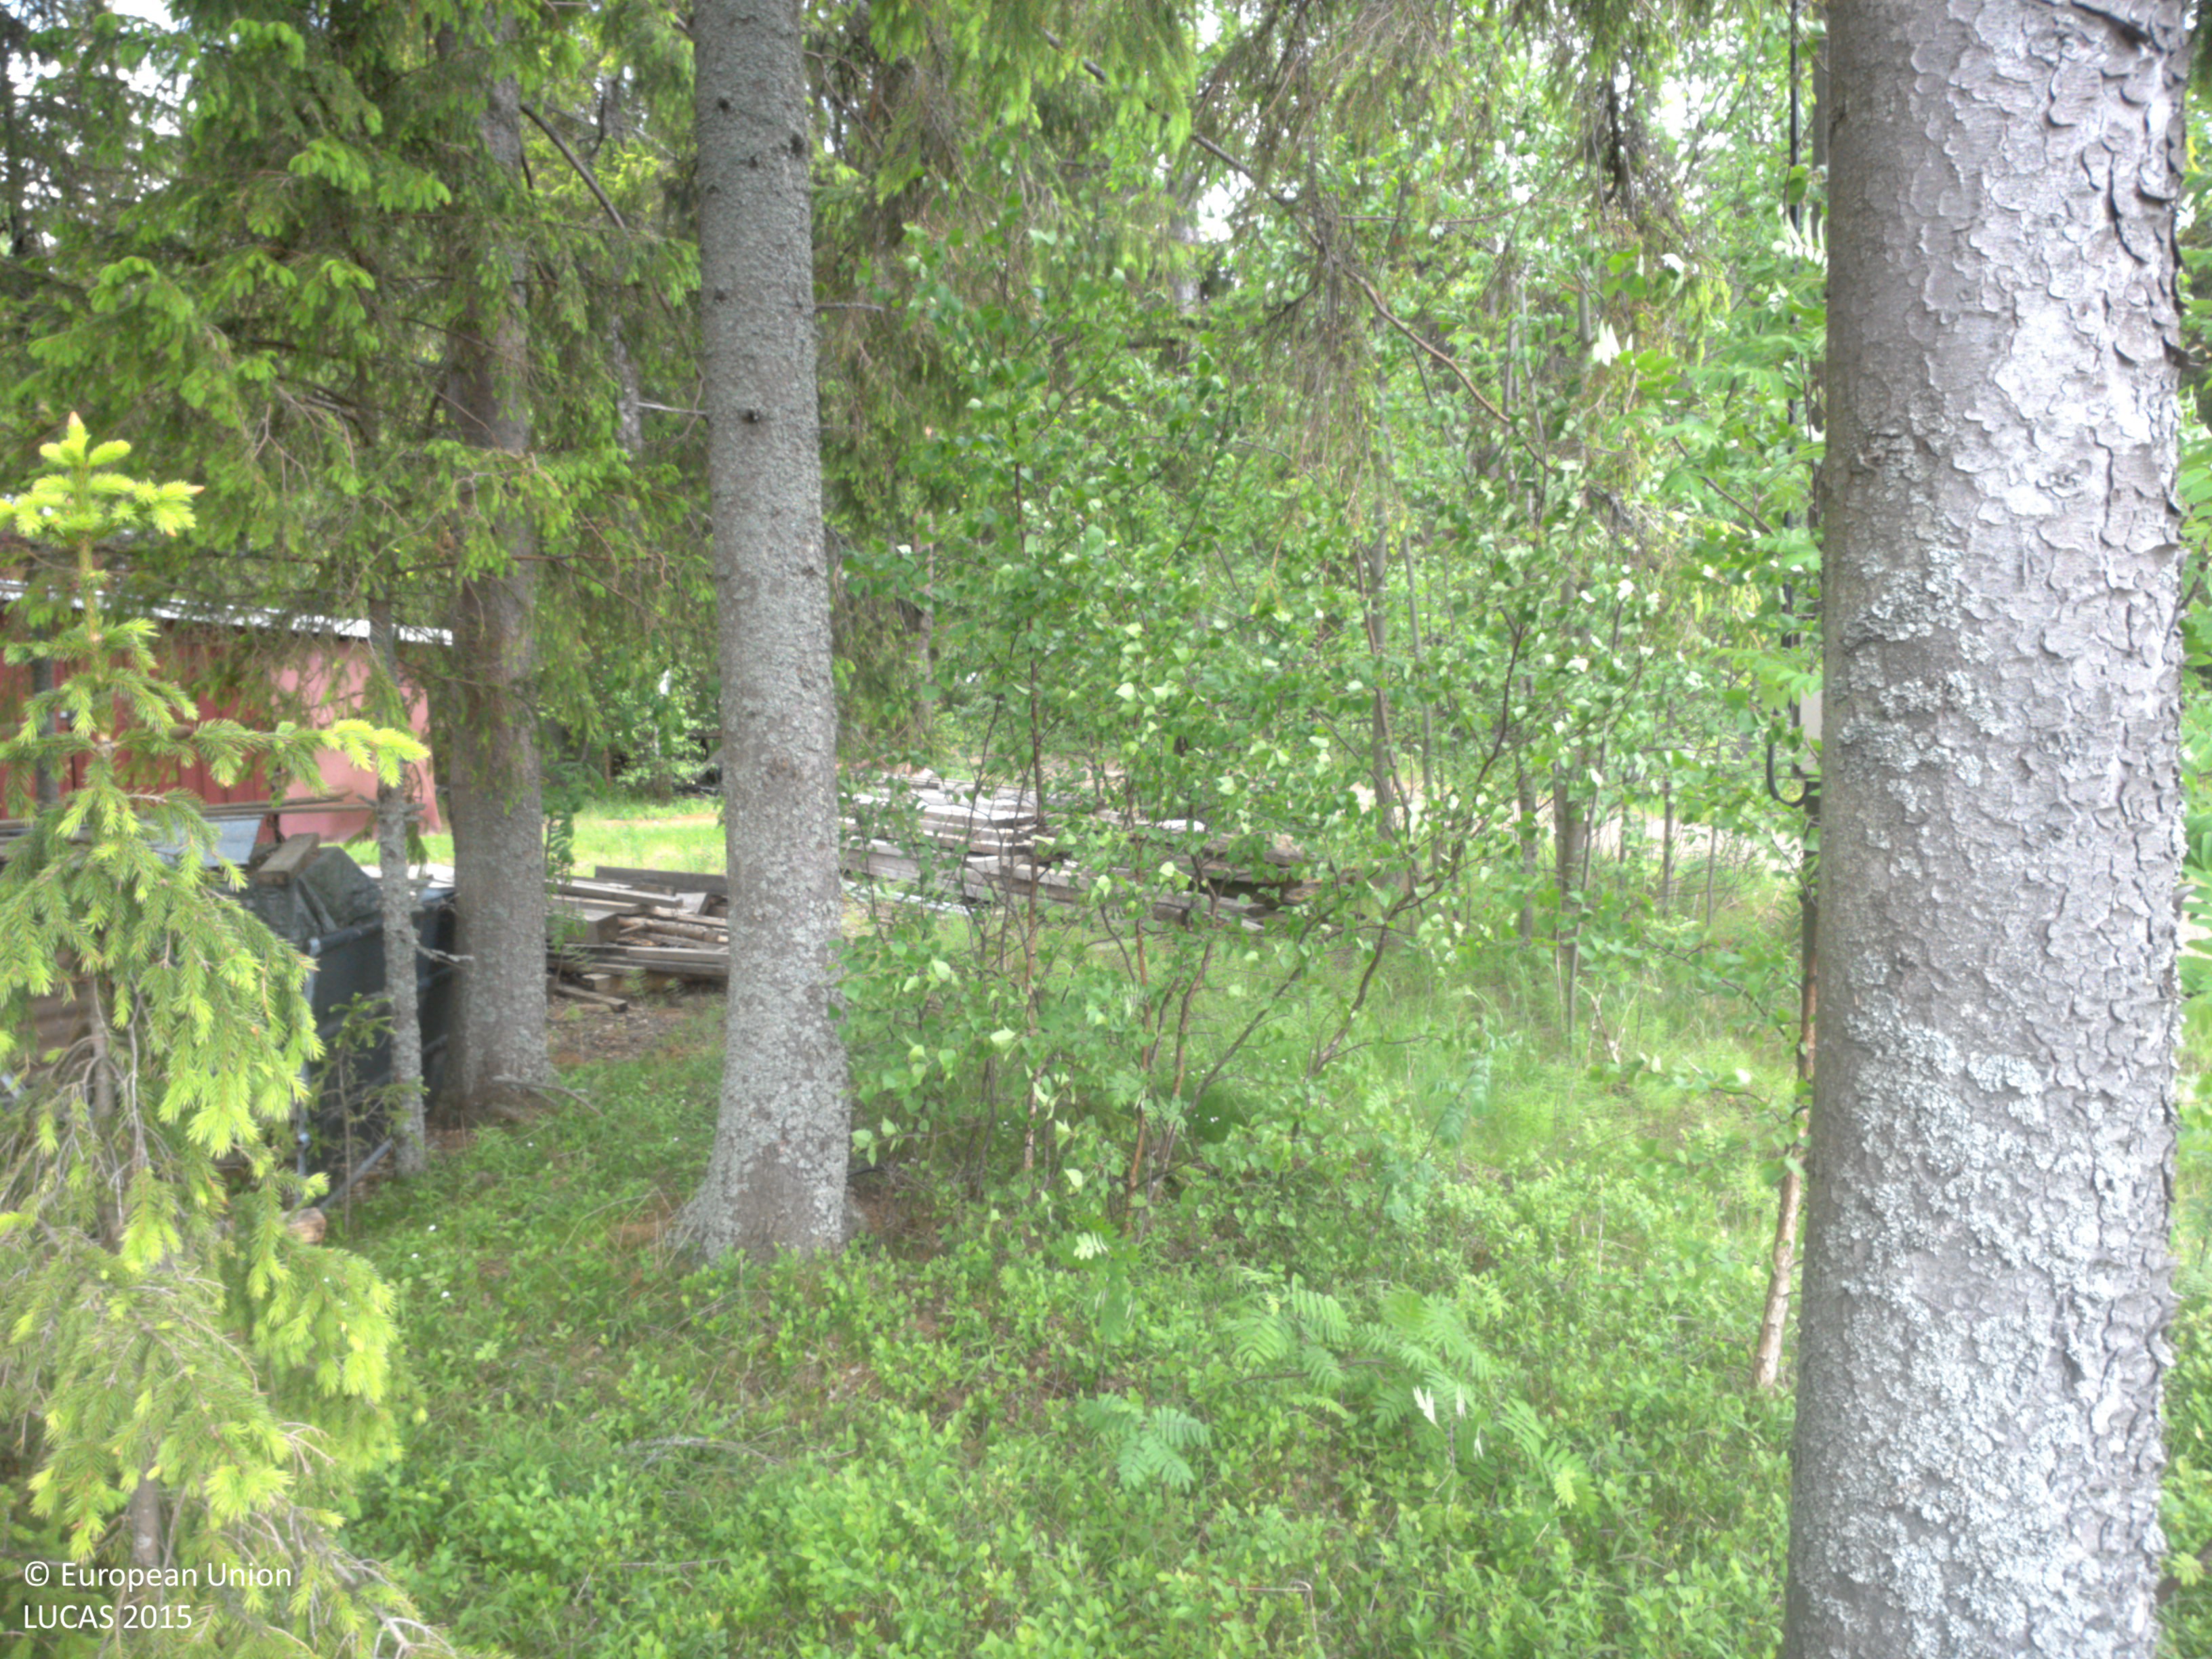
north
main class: Woodland
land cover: Spruce dominated coniferous woodland
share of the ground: 25 - 50 %
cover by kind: coniferous forest trees 50 %, consolidated bare surface 40 %, herbaceous plants 10 %
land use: Residential
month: June
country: SE
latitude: 63.5977
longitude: 19.8783
